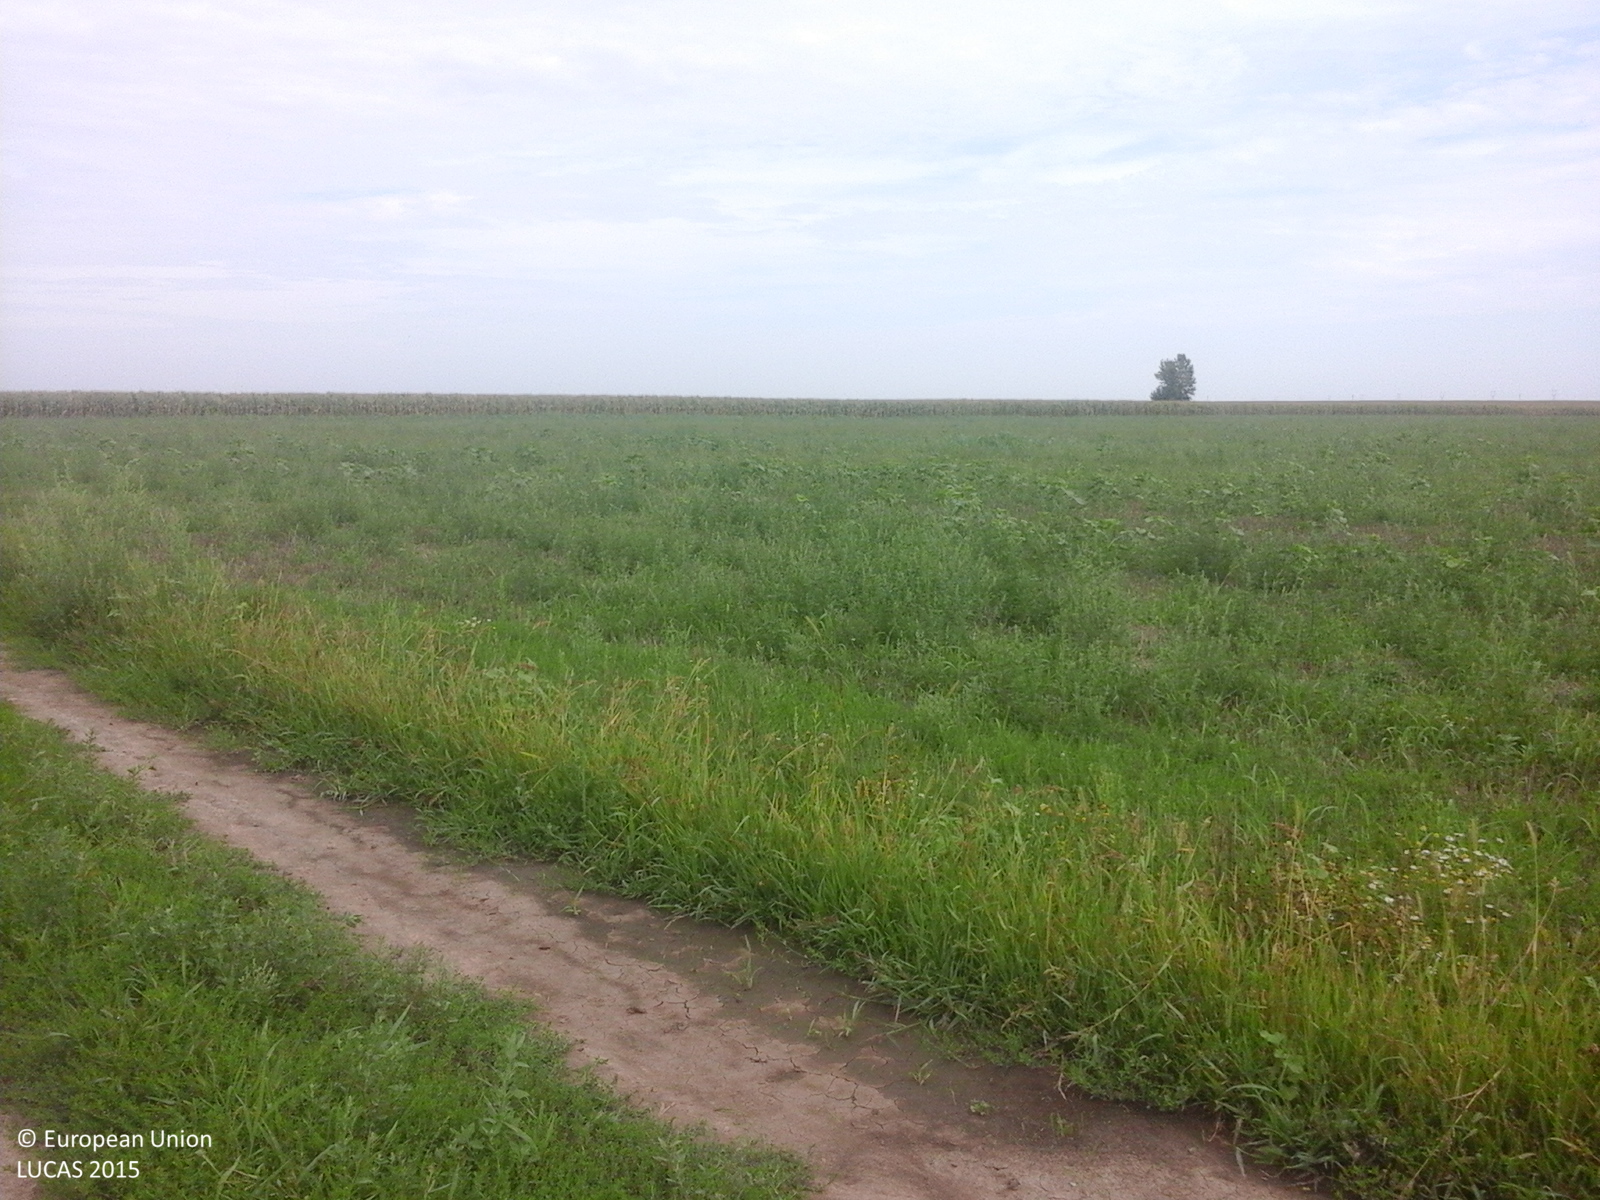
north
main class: Cropland
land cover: Sunflower
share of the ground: > 75 %
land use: Agriculture (excluding fallow land and kitchen gardens)
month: August
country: RO
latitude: 46.3869
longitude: 21.4667
